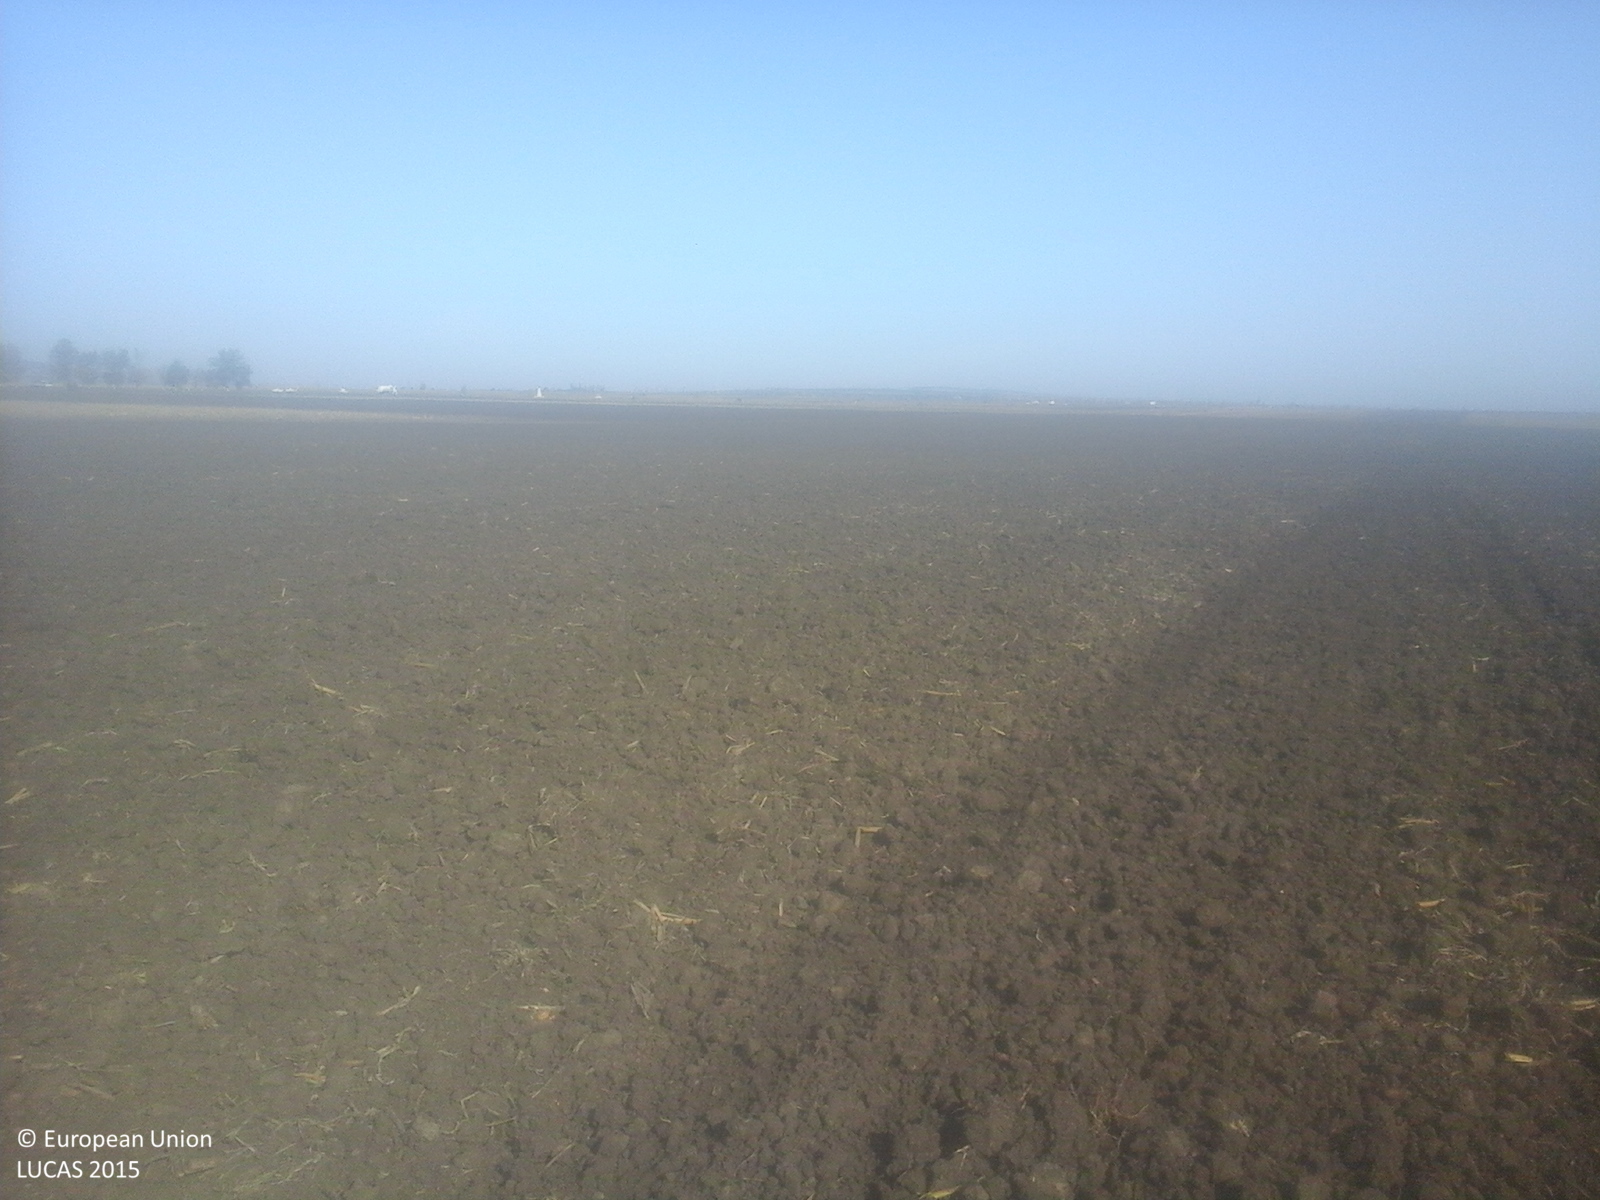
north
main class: Cropland
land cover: Common wheat
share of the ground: < 10 %
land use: Agriculture (excluding fallow land and kitchen gardens)
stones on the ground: < 10 %
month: October
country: RO
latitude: 45.2530
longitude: 26.8894
